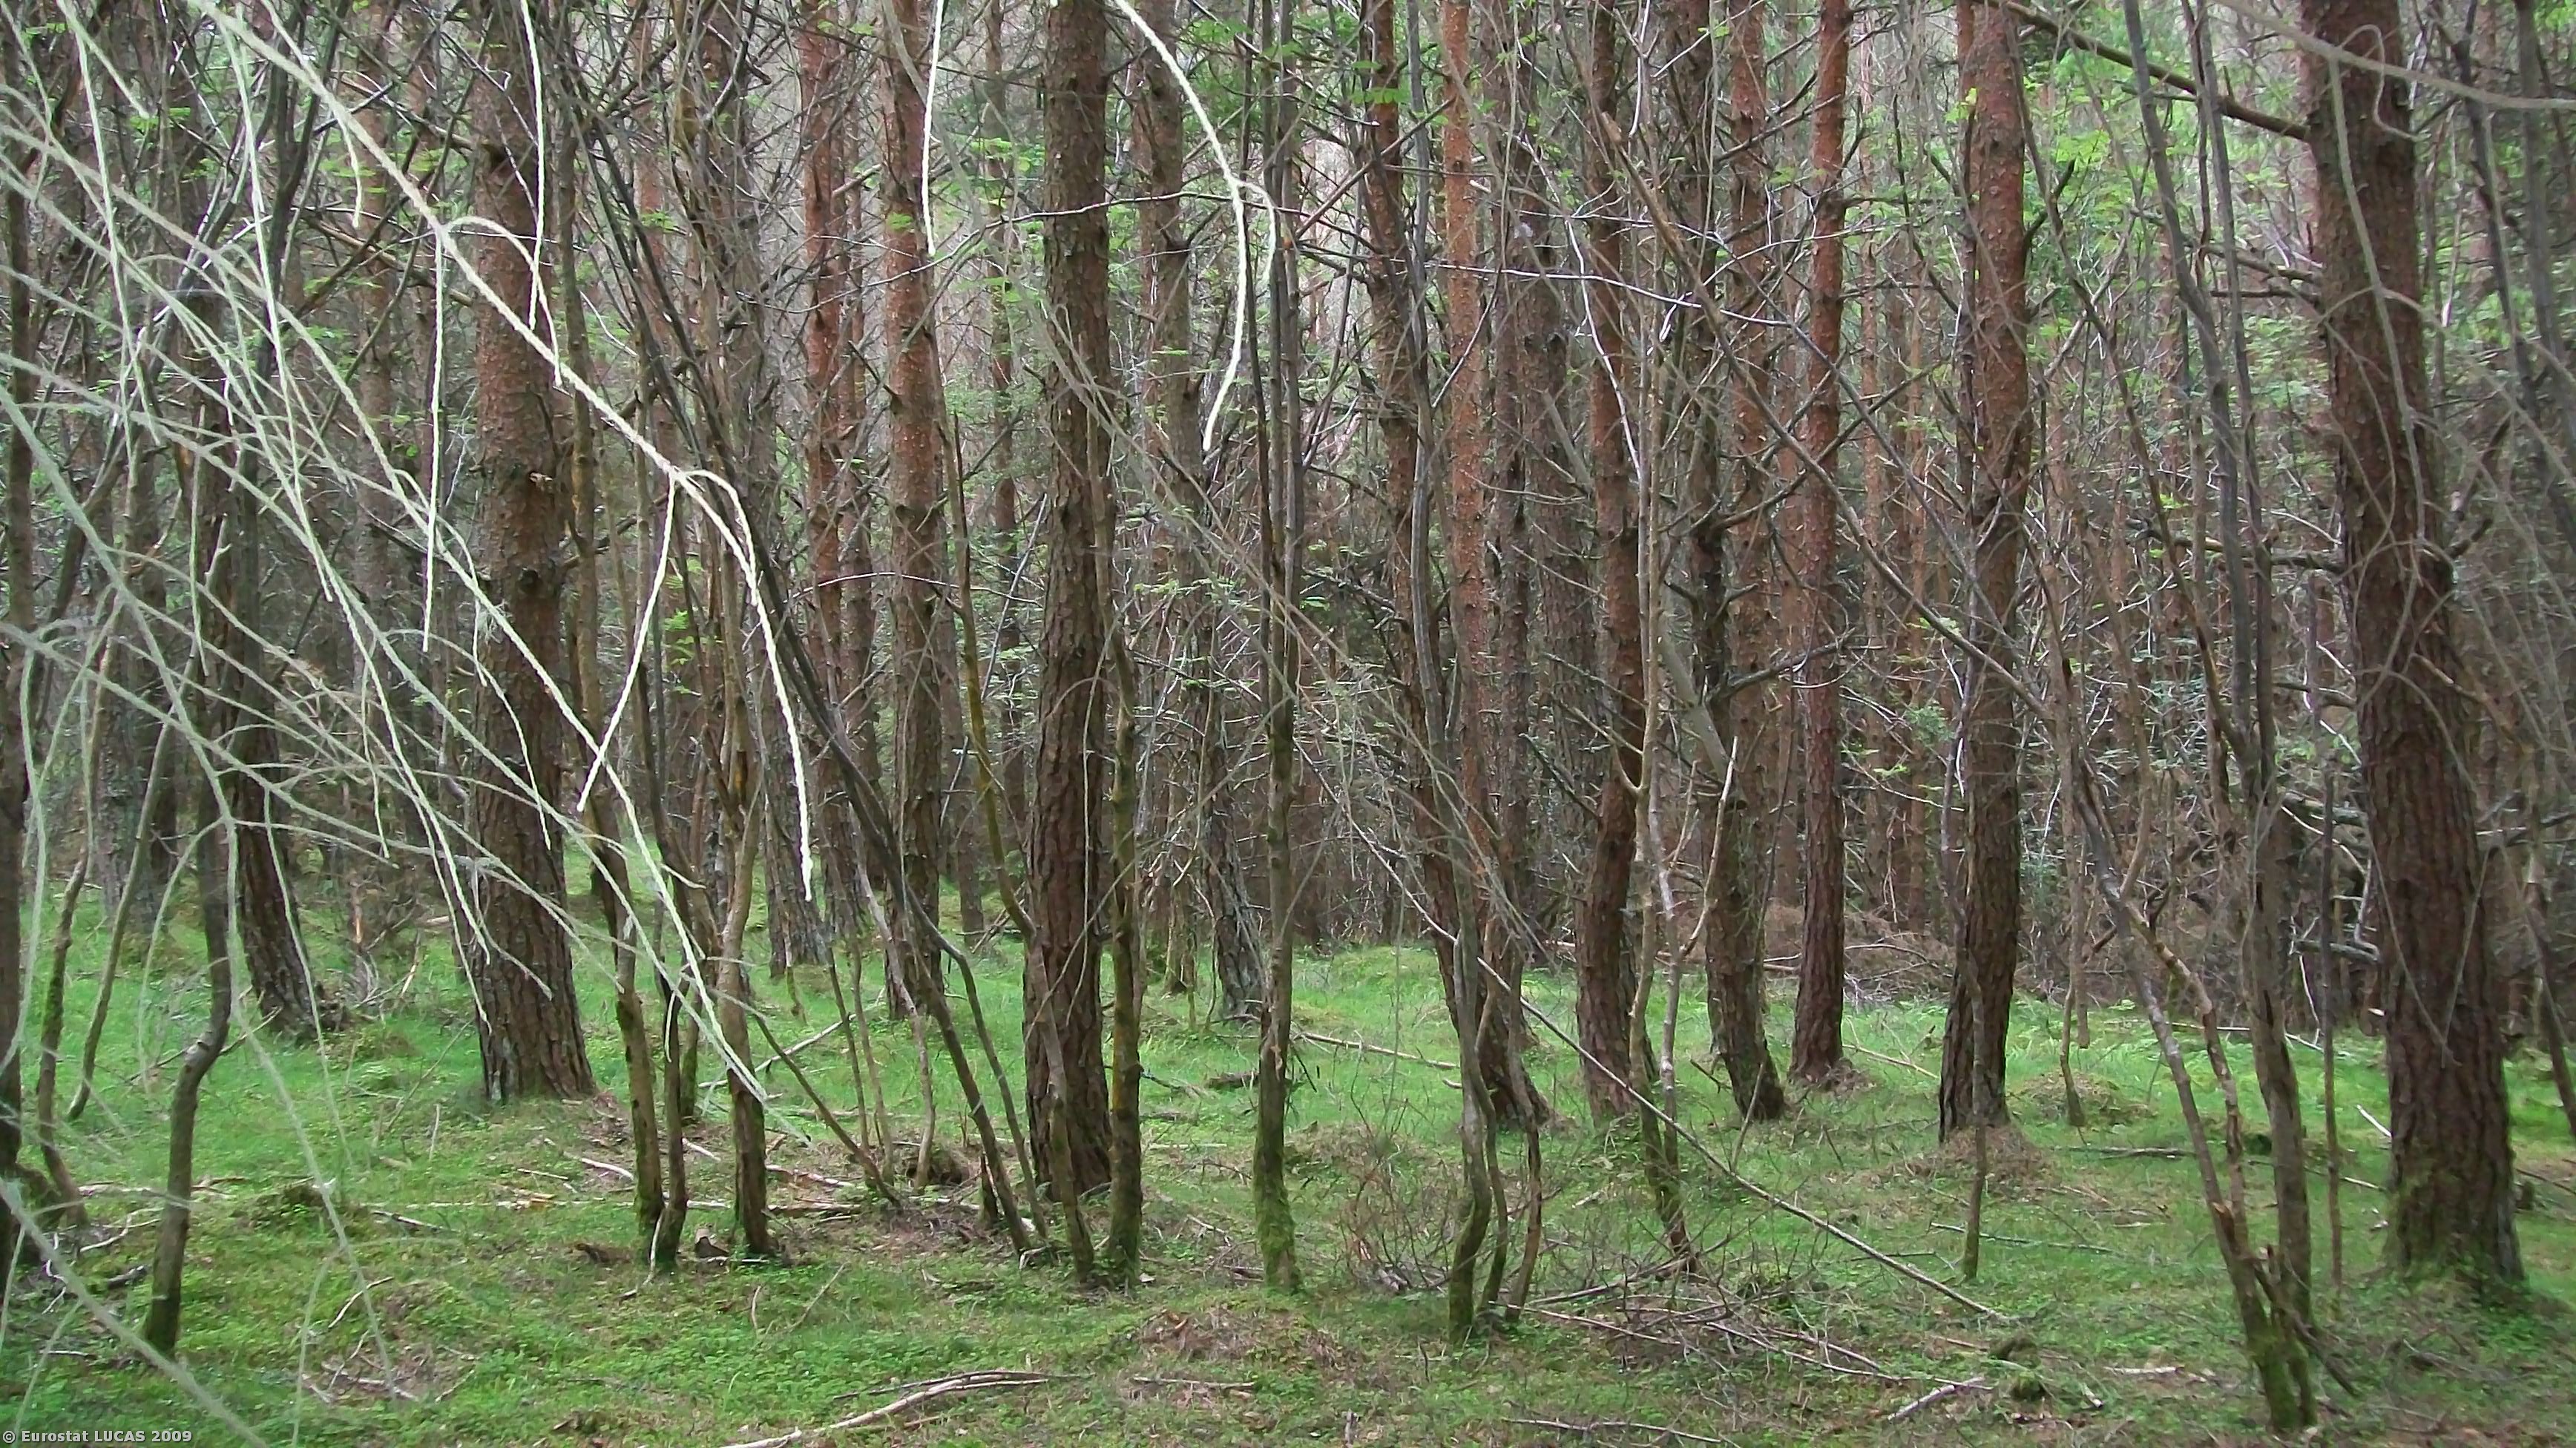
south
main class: Woodland
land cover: Mixed woodland
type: mesophytic deciduous forest
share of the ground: > 75 %
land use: Forestry
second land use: Amenities, museums, leisure
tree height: > 5 m
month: June
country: GB
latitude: 57.6514
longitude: -2.8771
